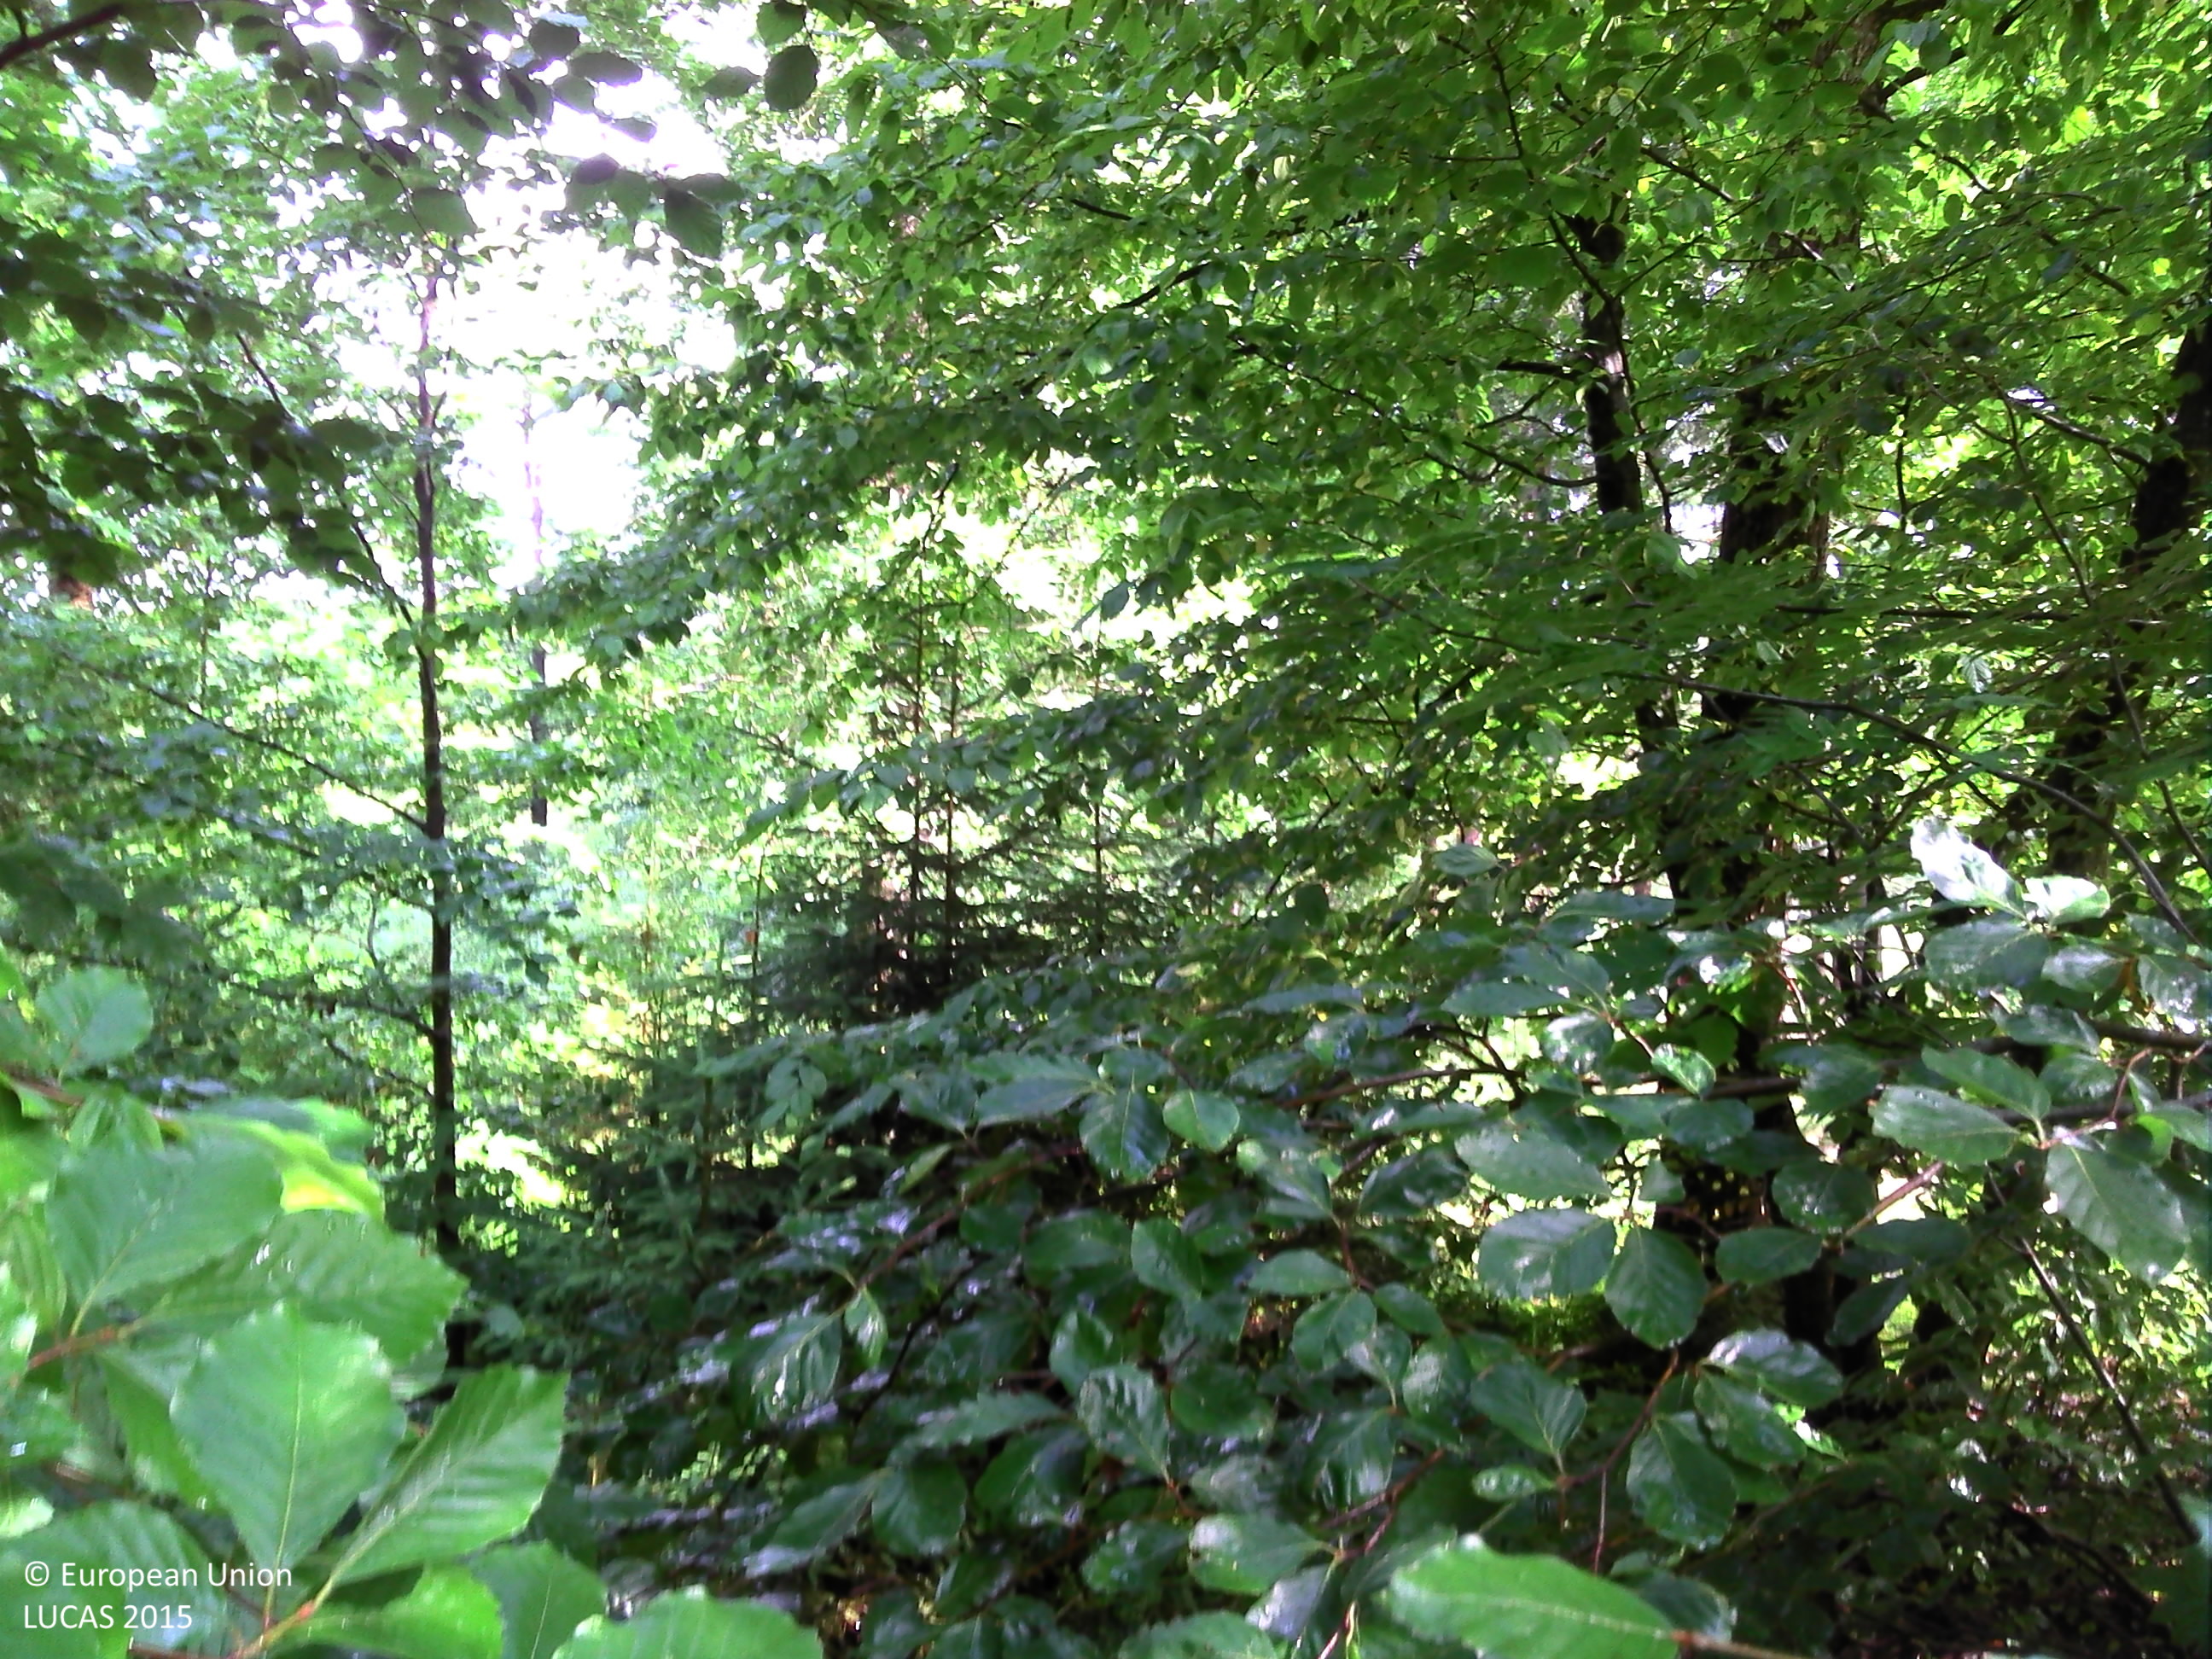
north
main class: Woodland
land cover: Pine dominated mixed woodland
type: hemiboreal forest and nemoral coniferous forest and mixed broadleaved-coniferous forest
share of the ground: > 75 %
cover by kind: broadleaved forest trees 50 %, coniferous forest trees 40 %, herbaceous plants 10 %
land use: Forestry
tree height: > 5 m
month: July
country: BE
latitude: 50.5055
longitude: 5.8675
